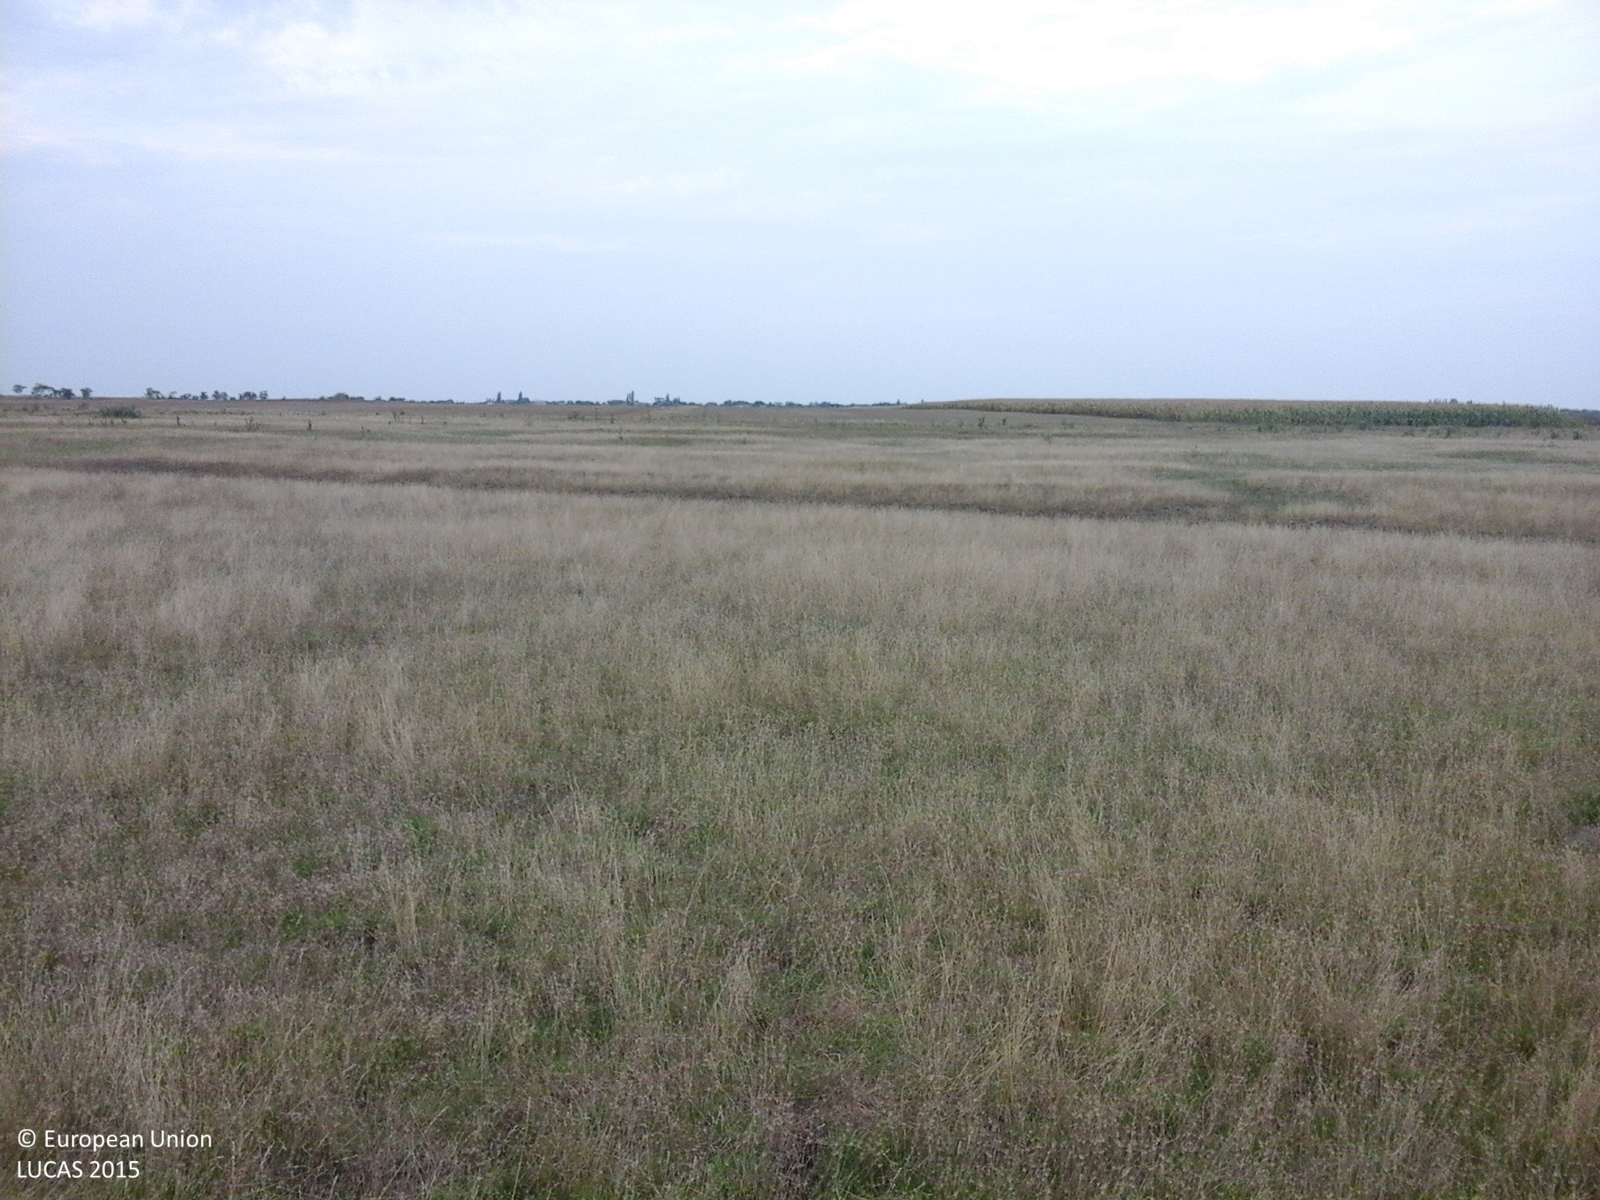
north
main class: Grassland
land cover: Grassland without tree/shrub cover
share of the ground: > 75 %
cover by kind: herbaceous plants 100 %
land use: Agriculture (excluding fallow land and kitchen gardens)
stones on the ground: < 10 %
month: August
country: RO
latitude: 46.3405
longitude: 21.2200
